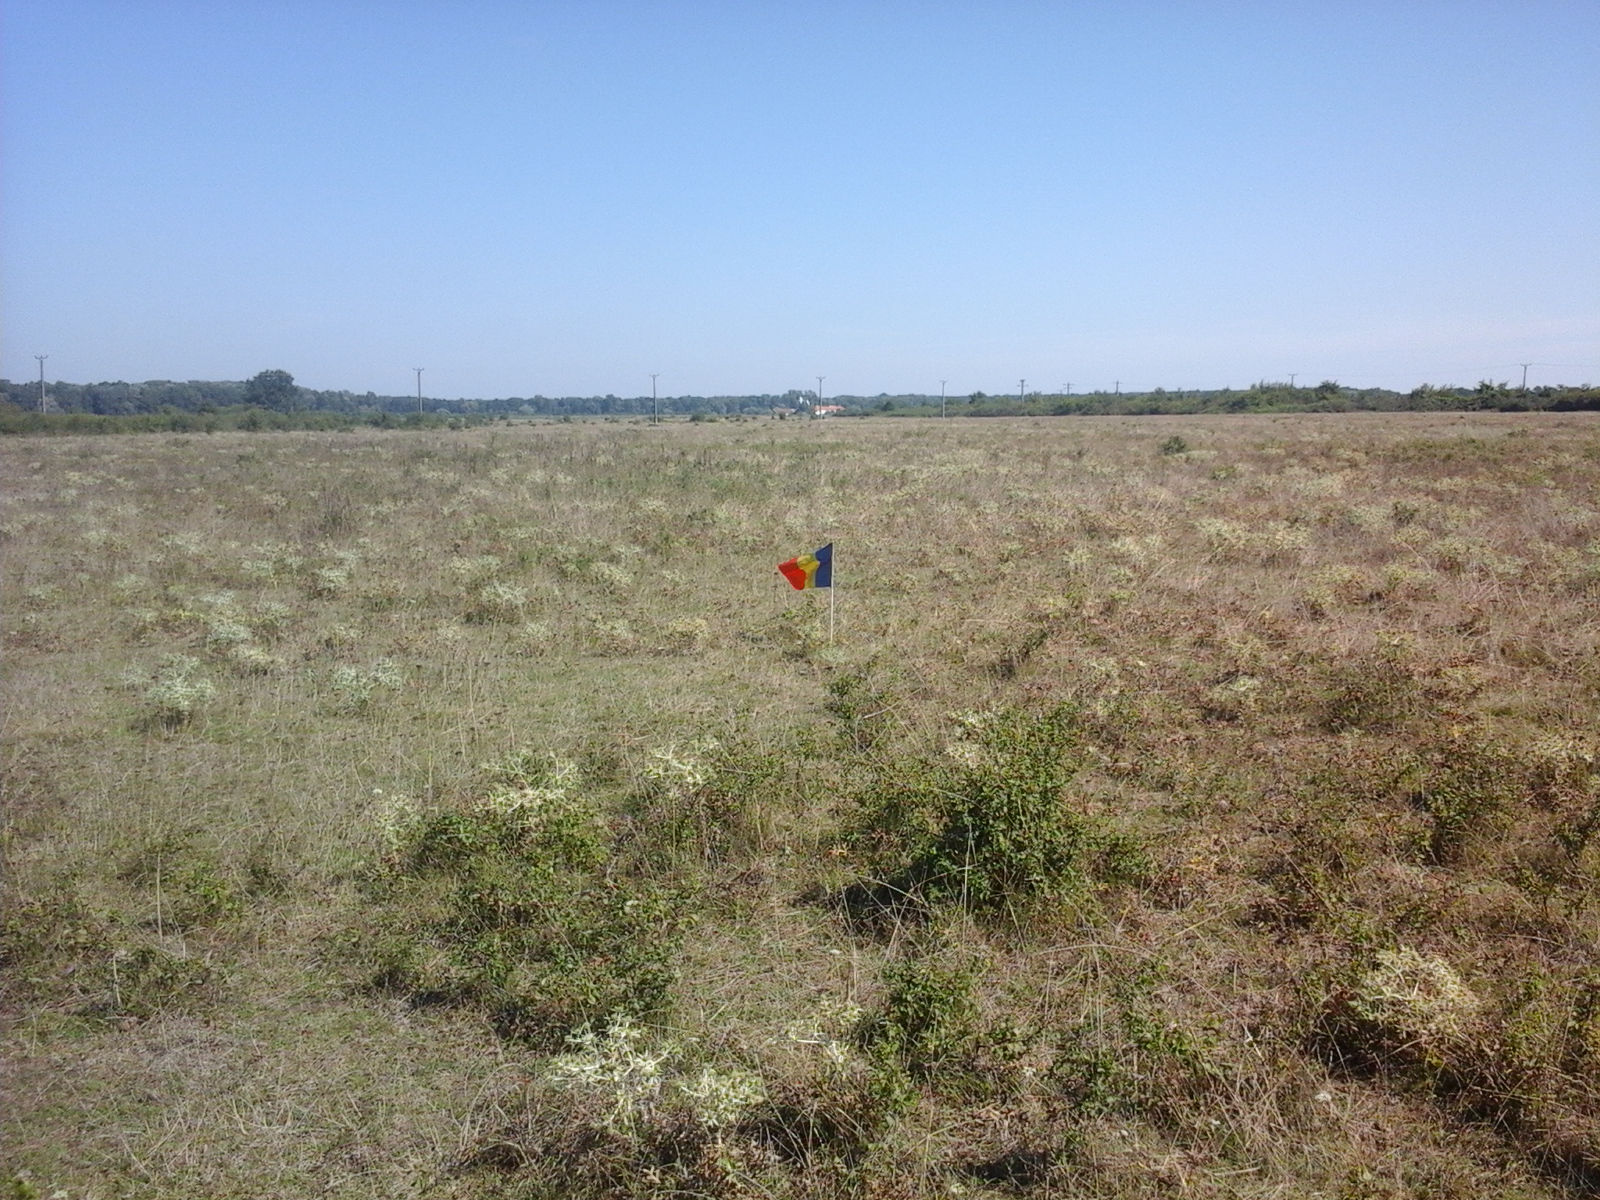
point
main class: Grassland
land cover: Spontaneously vegetated surfaces
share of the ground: > 75 %
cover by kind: herbaceous plants 100 %
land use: Fallow land
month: August
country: RO
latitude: 46.1255
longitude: 21.0177
